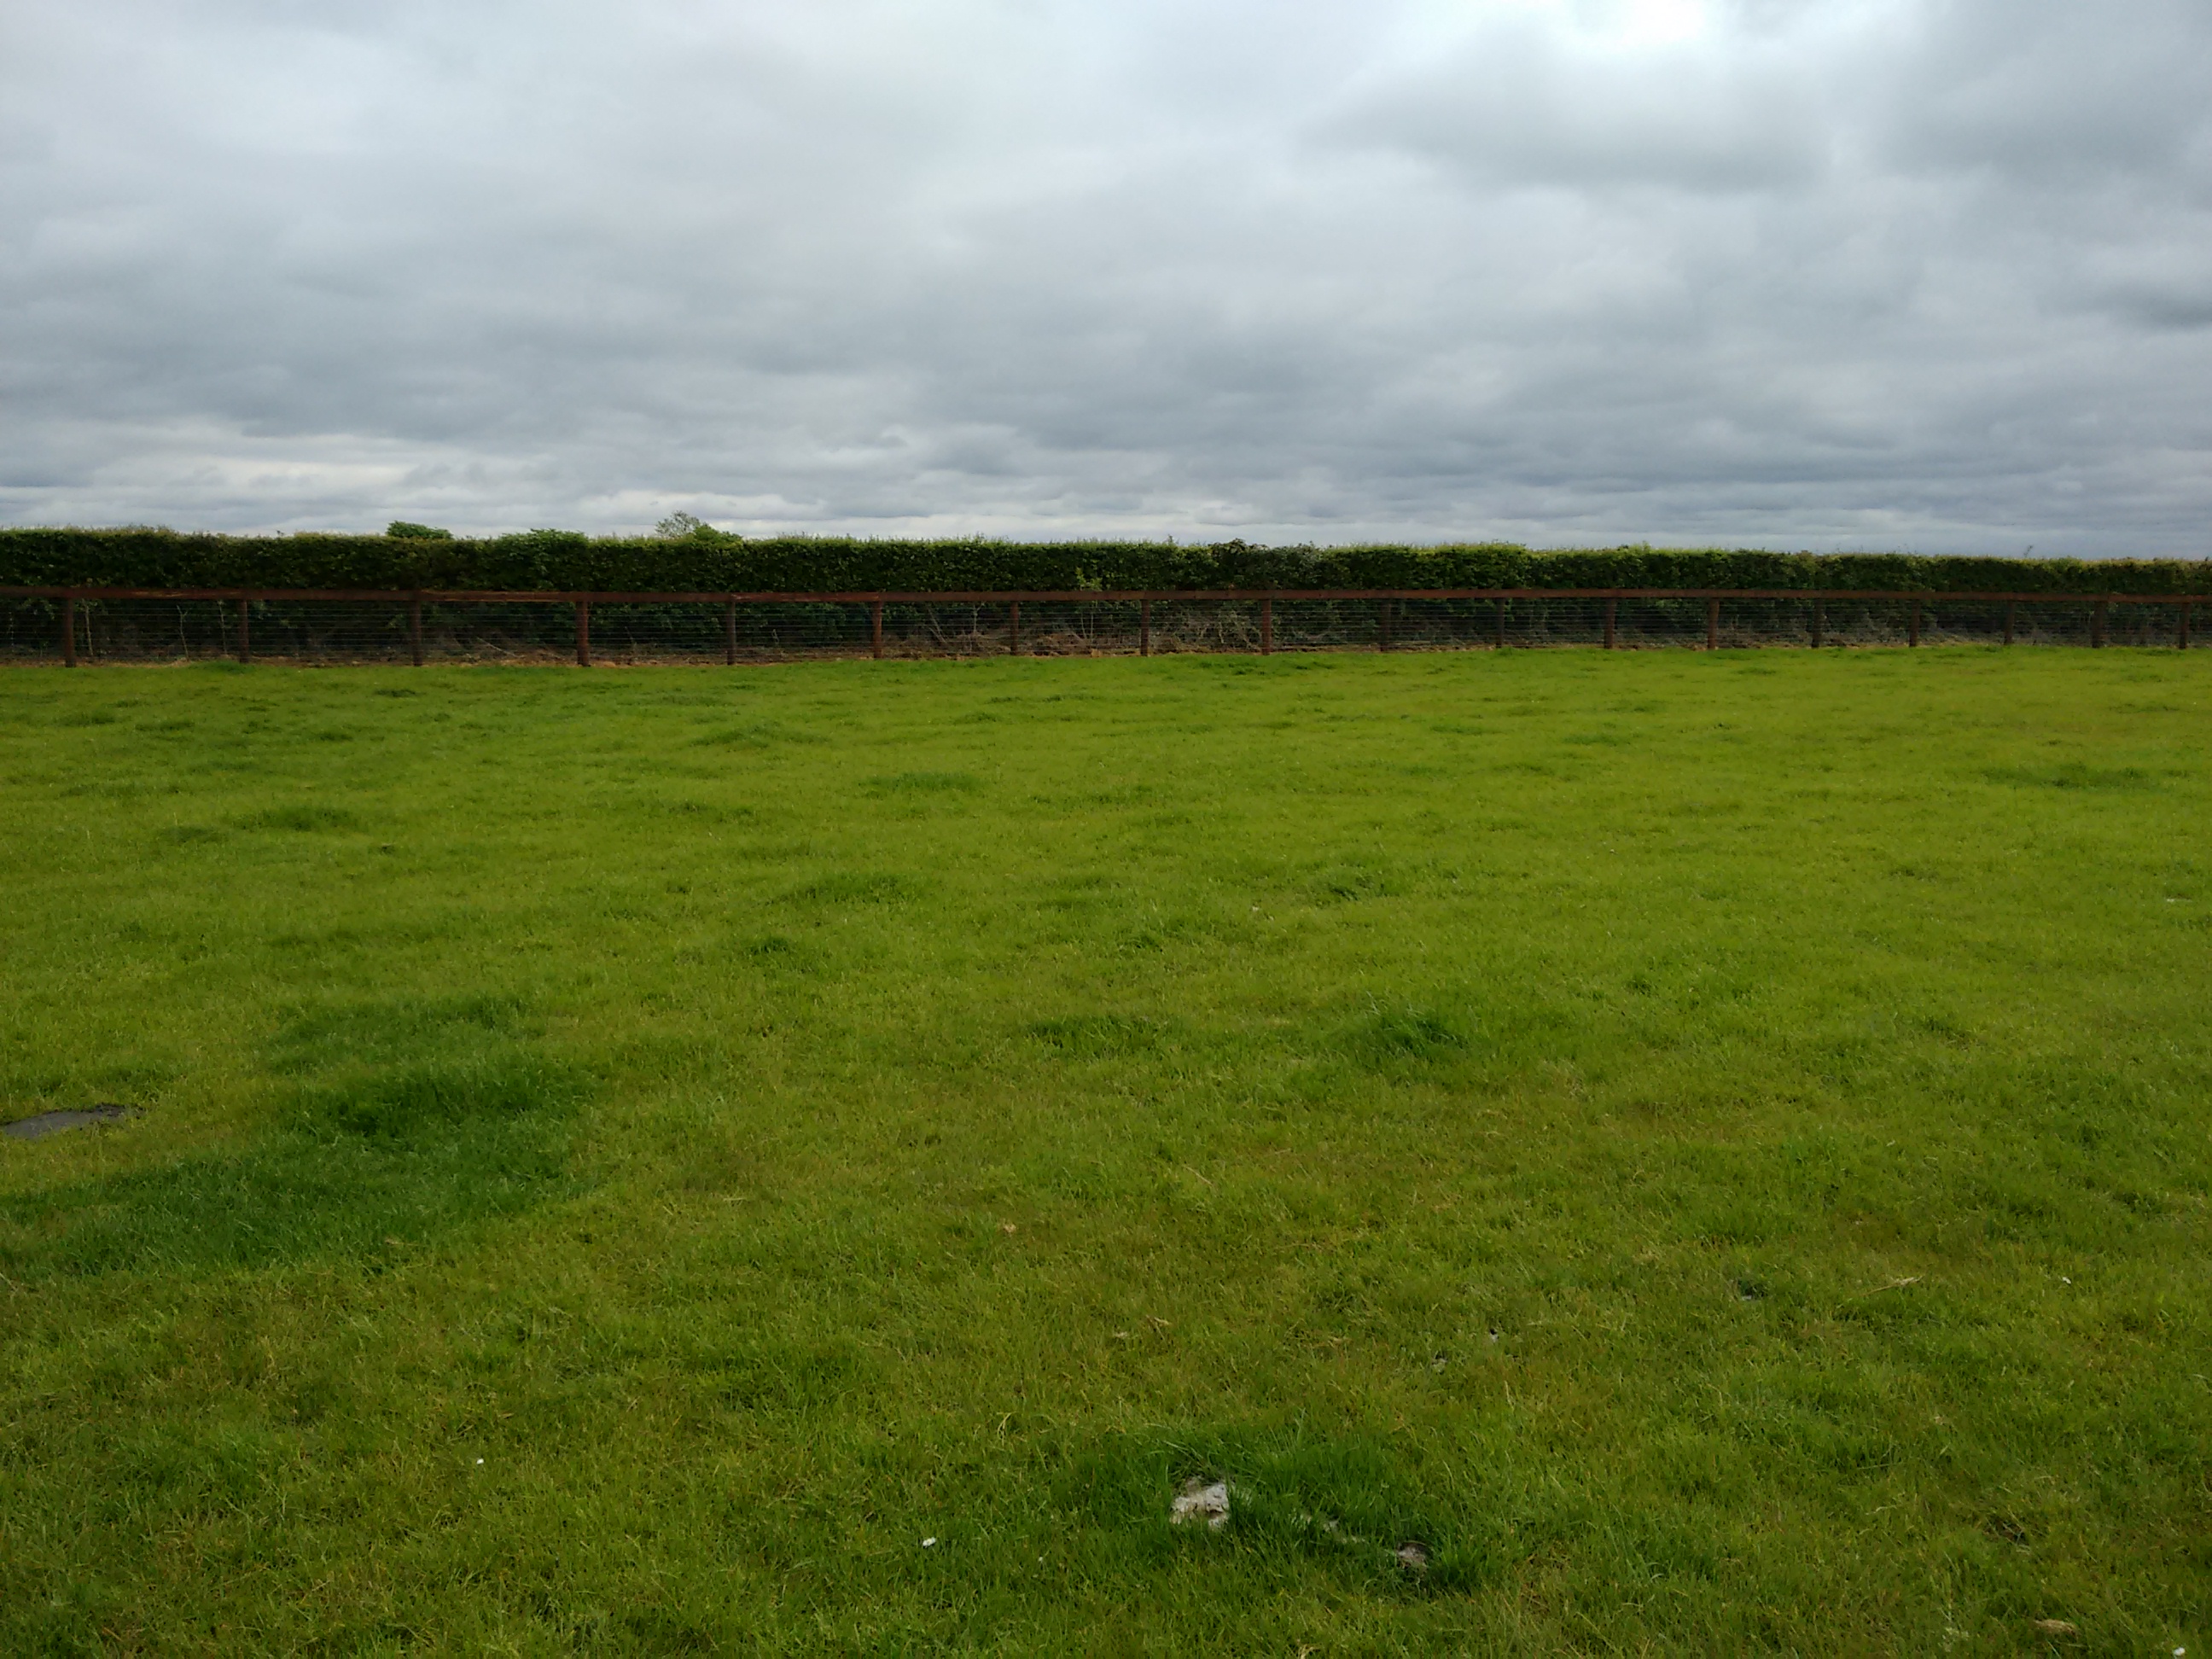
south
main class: Grassland
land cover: Grassland without tree/shrub cover
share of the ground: > 75 %
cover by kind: herbaceous plants 95 %, unconsolidated bare surface 5 %
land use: Agriculture (excluding fallow land and kitchen gardens)
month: May
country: IE
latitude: 53.4251
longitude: -6.7016
